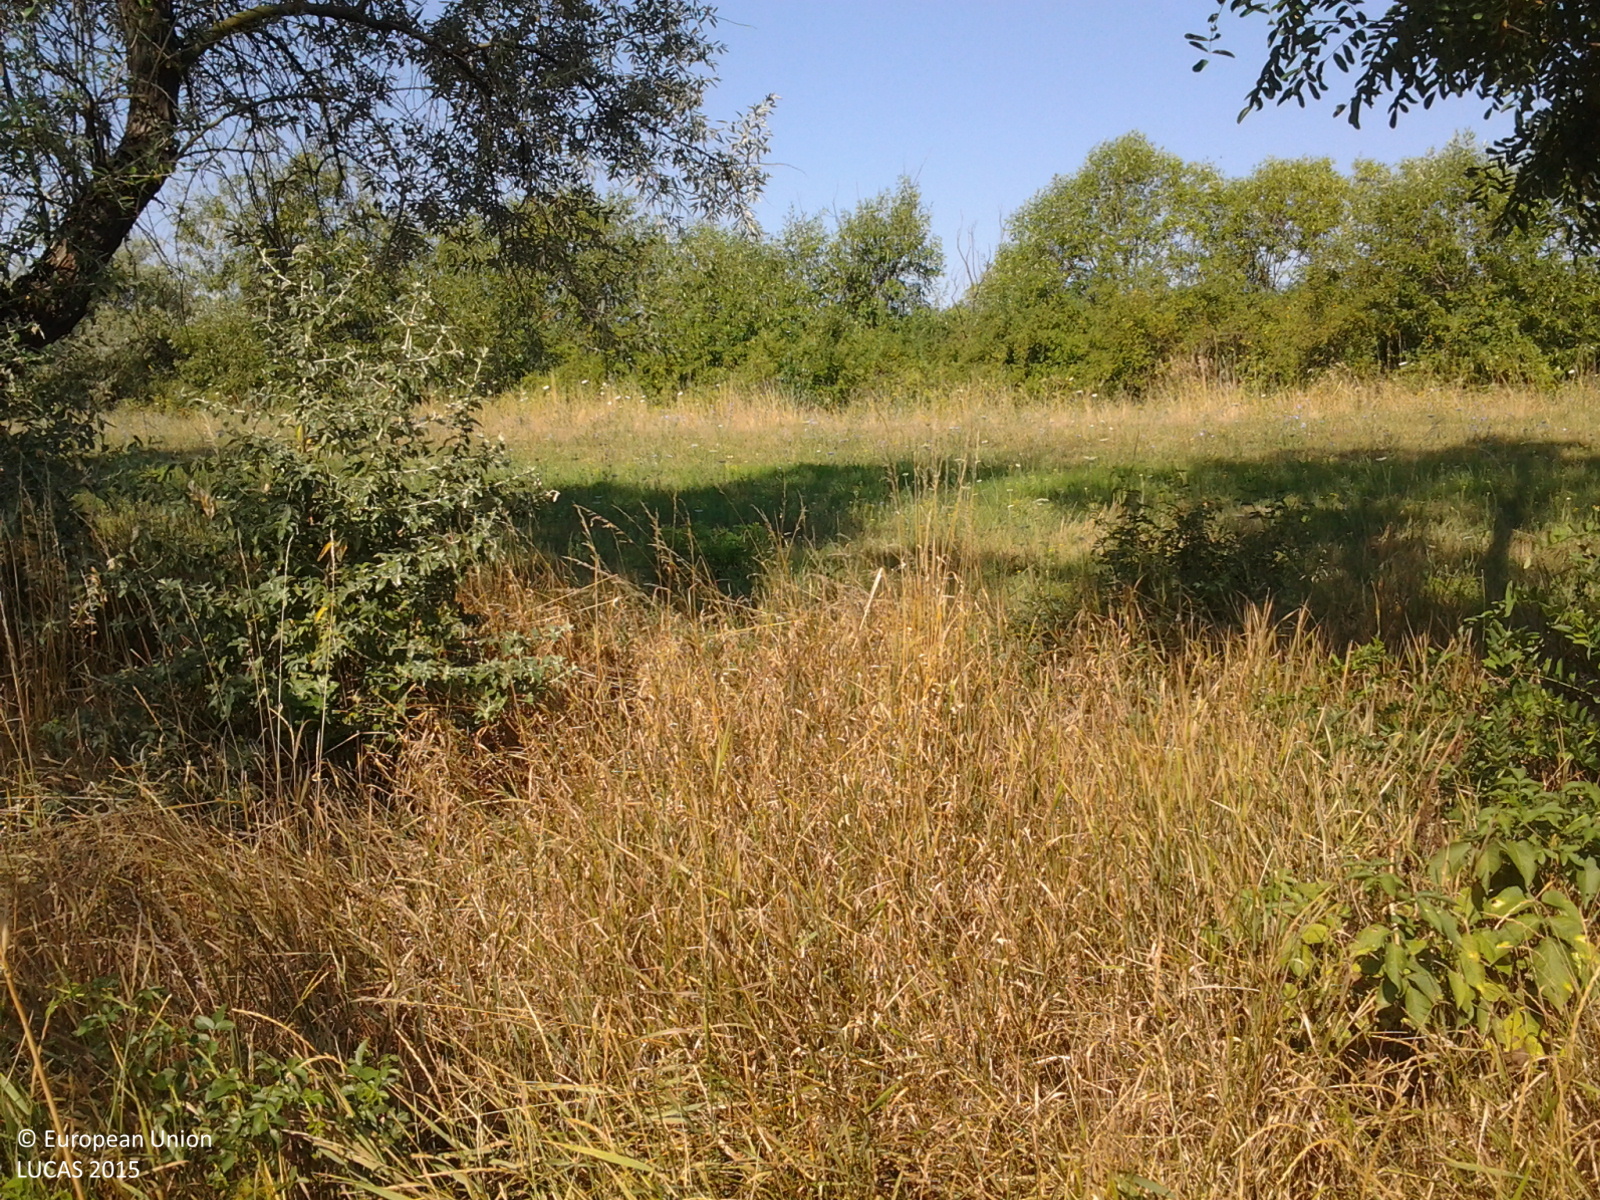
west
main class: Woodland
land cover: Broadleaved woodland
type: mire and swamp forests
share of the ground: 25 - 50 %
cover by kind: herbaceous plants 70 %, broadleaved forest trees 30 %
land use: Abandoned areas
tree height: < 5 m
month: July
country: HU
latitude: 47.3676
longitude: 20.5853
